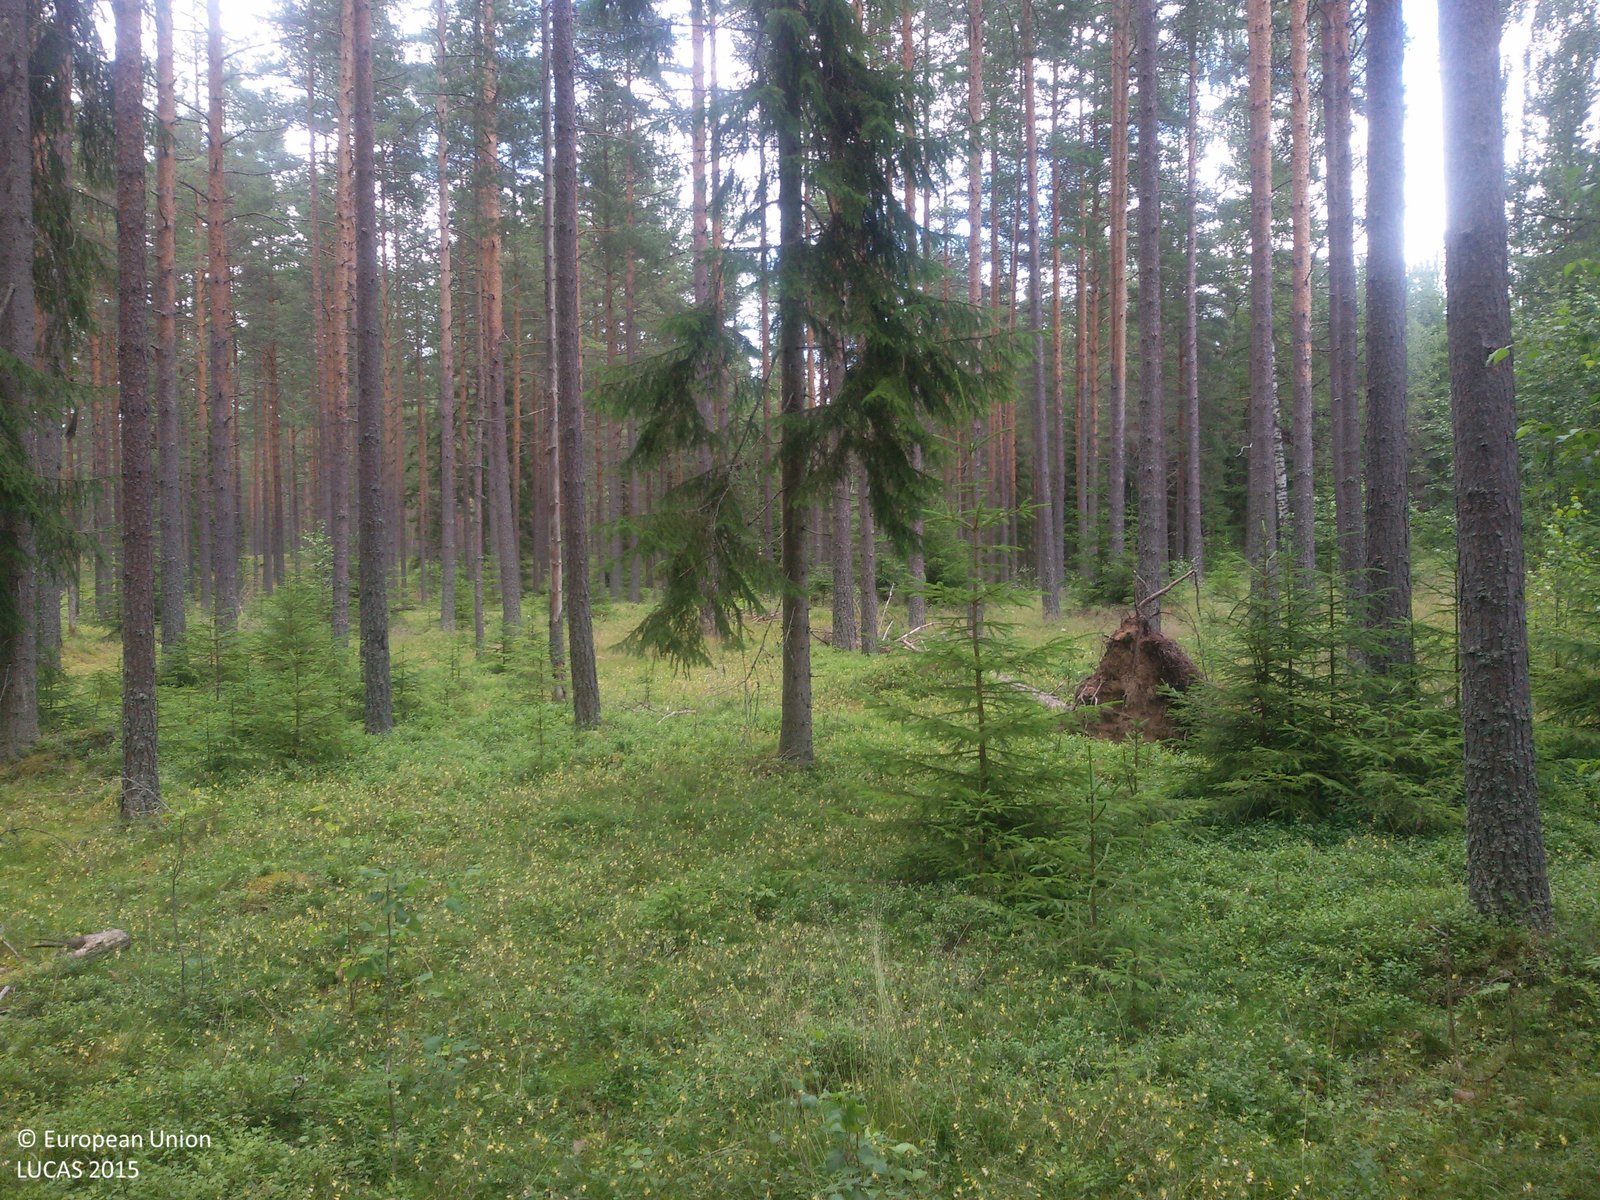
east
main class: Woodland
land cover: Pine dominated coniferous woodland
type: boreal forest
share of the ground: > 75 %
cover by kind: coniferous forest trees 65 %, shrubs 20 %, herbaceous plants 10 %, lichens and mosses 5 %
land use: Forestry
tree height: > 5 m
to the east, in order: Pine dominated coniferous woodland; Tracks; Pine dominated coniferous woodland
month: July
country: SE
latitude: 60.5313
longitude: 15.3270
